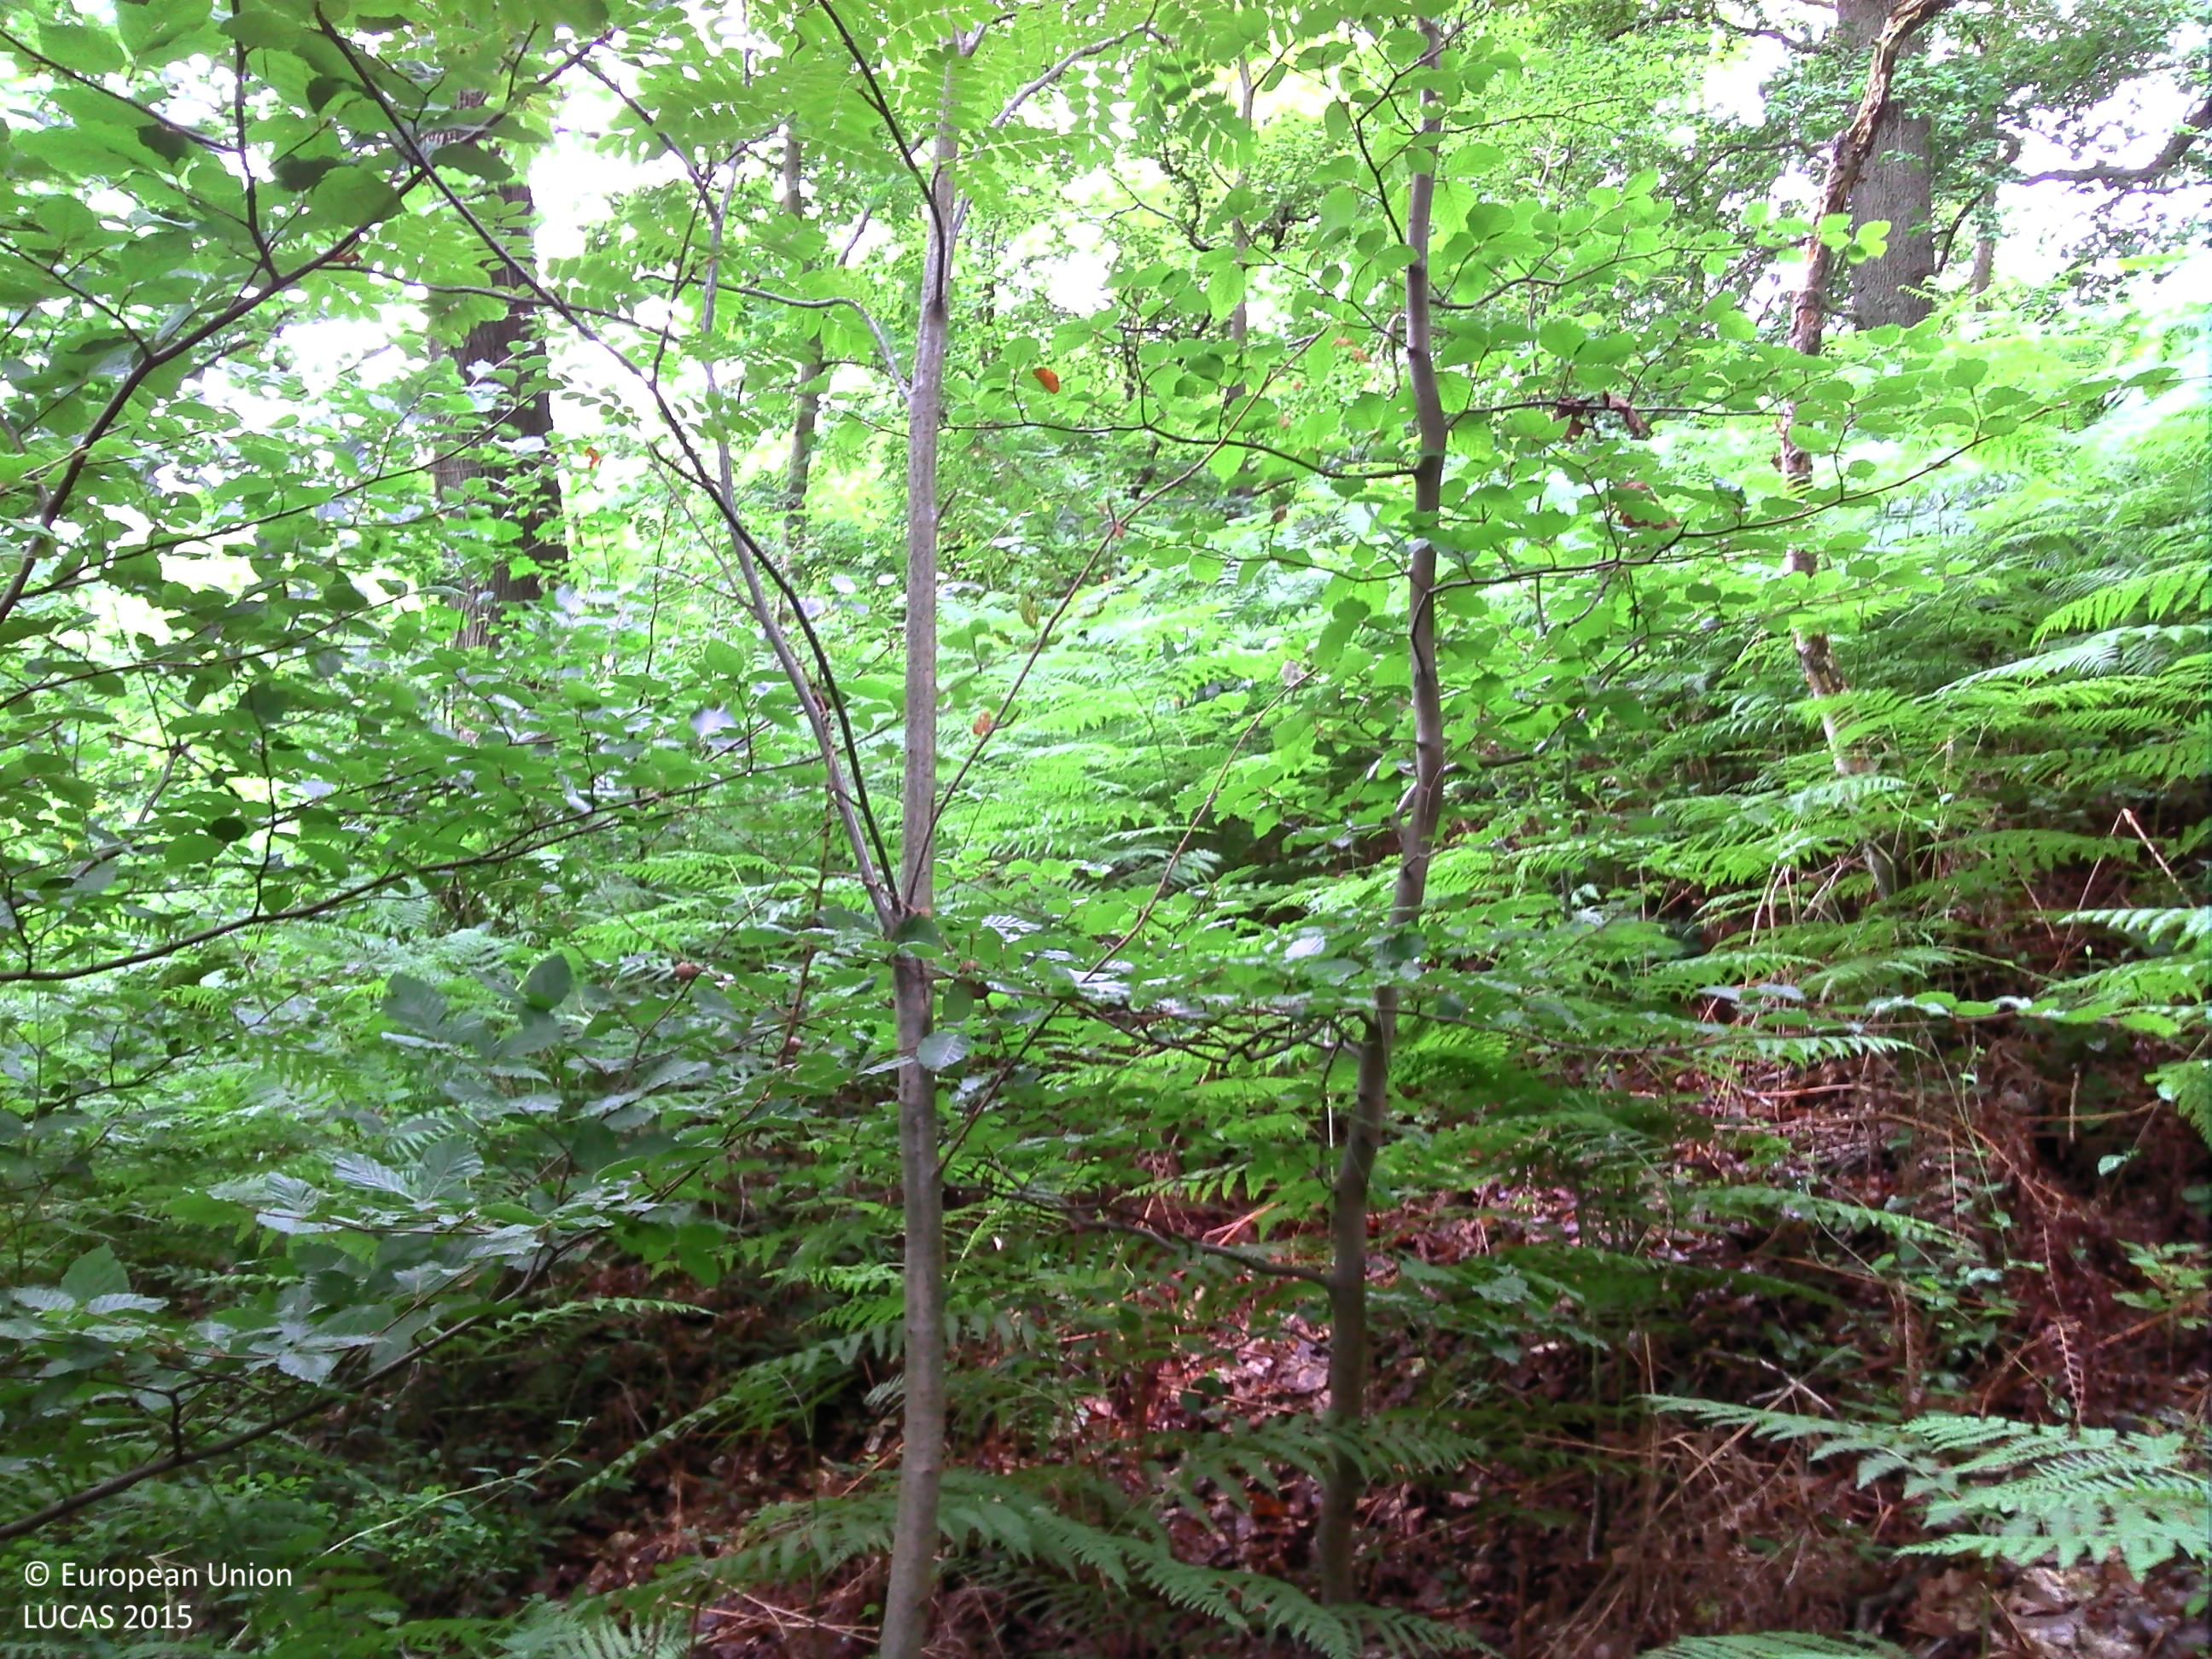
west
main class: Woodland
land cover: Broadleaved woodland
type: acidophilous oak and oak-birch forest
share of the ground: > 75 %
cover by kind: broadleaved forest trees 80 %, herbaceous plants 20 %
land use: Forestry
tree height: > 5 m
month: July
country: BE
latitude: 50.5265
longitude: 5.4700
